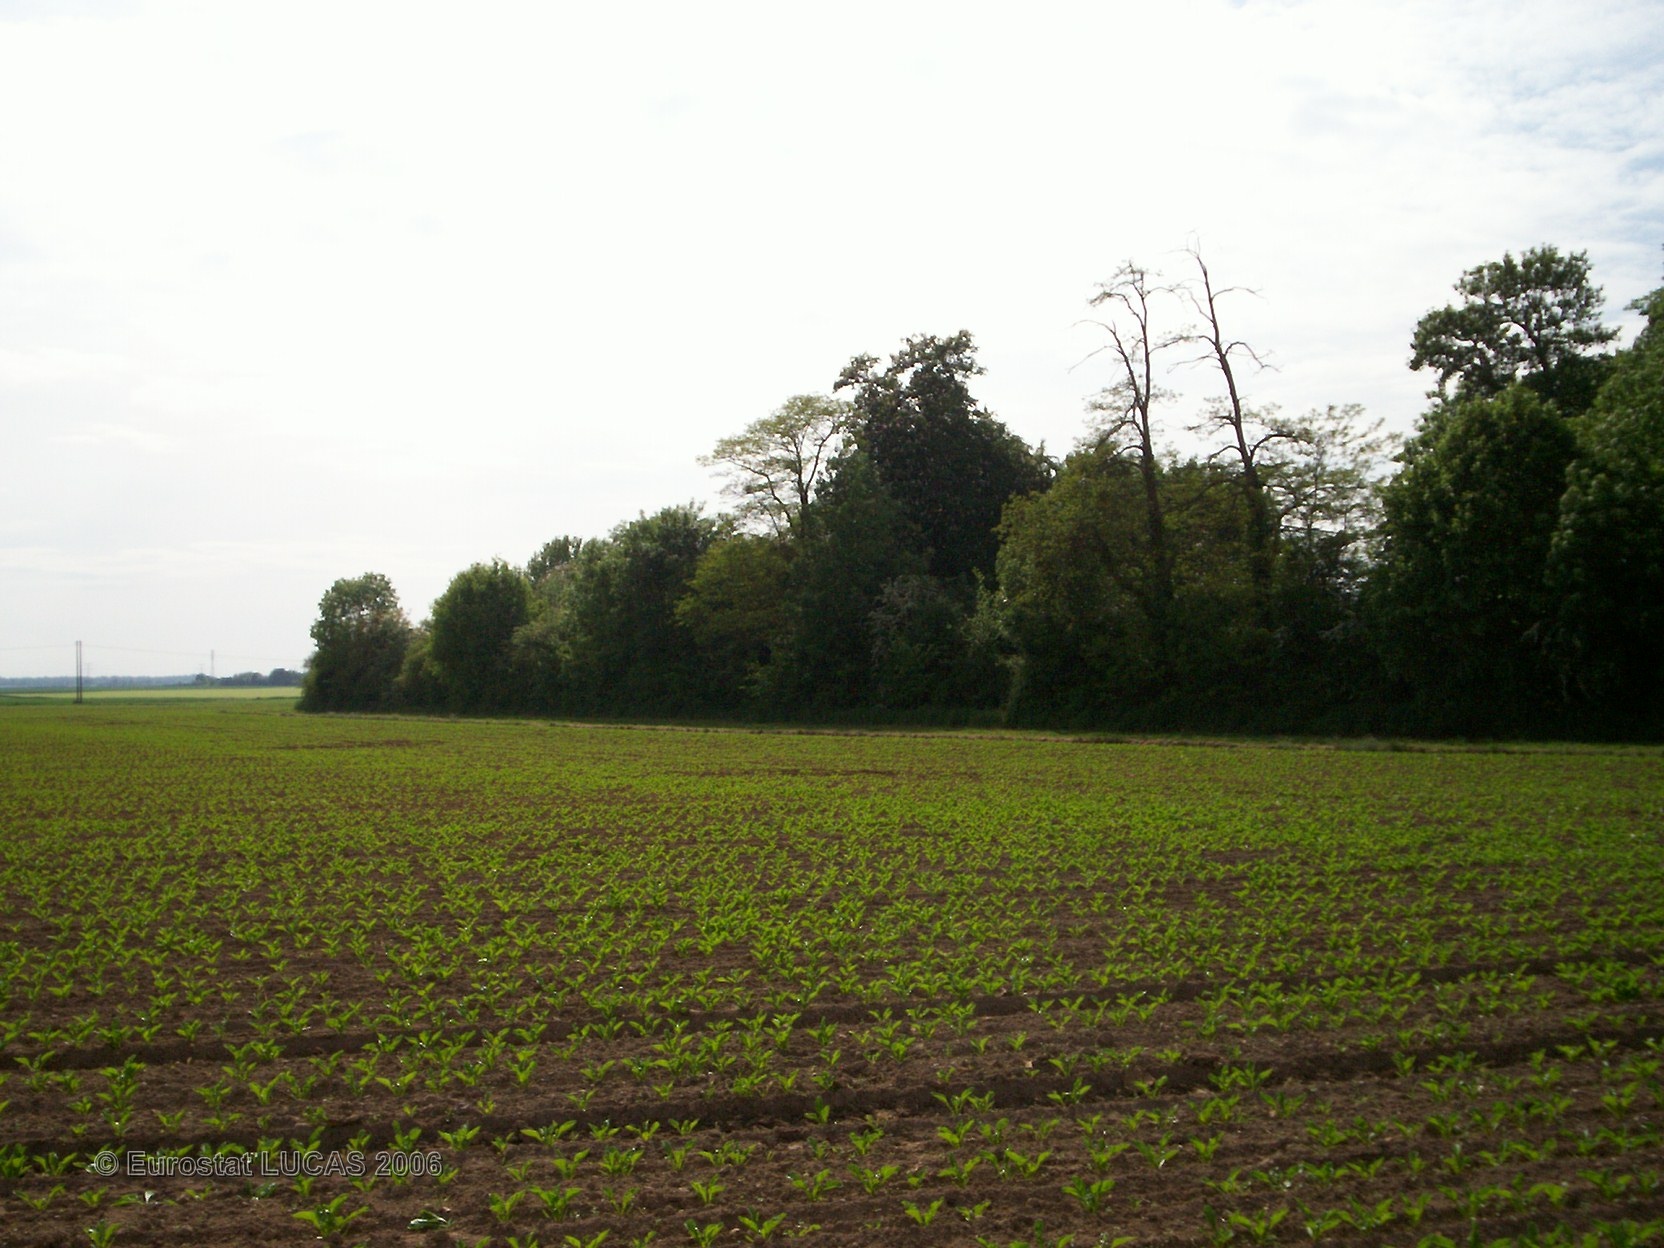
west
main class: Cropland
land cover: Sugar beet
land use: Agriculture (excluding fallow land and kitchen gardens)
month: May
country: FR
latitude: 48.6425
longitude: 2.8658
